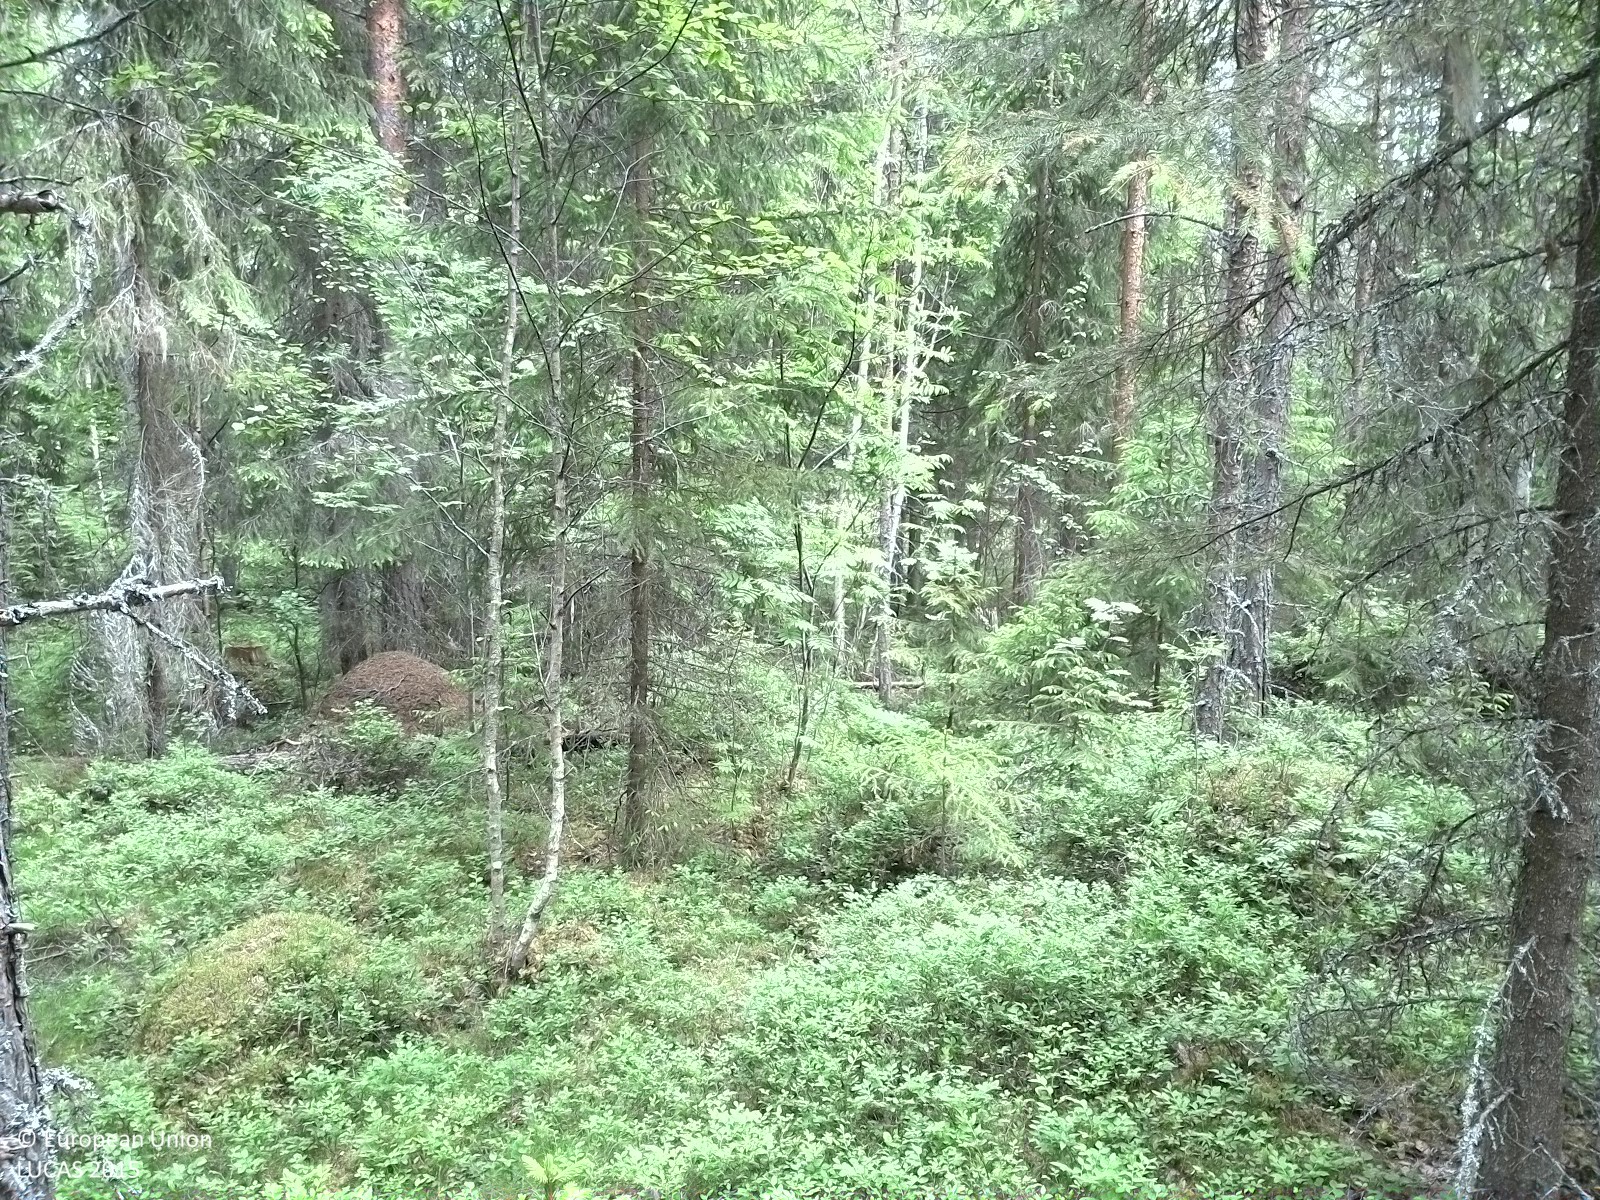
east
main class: Woodland
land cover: Pine dominated mixed woodland
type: boreal forest
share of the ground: 50 - 75 %
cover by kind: coniferous forest trees 35 %, shrubs 30 %, broadleaved forest trees 25 %, lichens and mosses 10 %
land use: Forestry
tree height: > 5 m
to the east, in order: Pine dominated mixed woodland; Spruce dominated mixed woodland; Broadleaved woodland; Ditches and canals; Other leguminous and mixtures for fodder
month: June
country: SE
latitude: 62.0491
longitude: 16.2351
